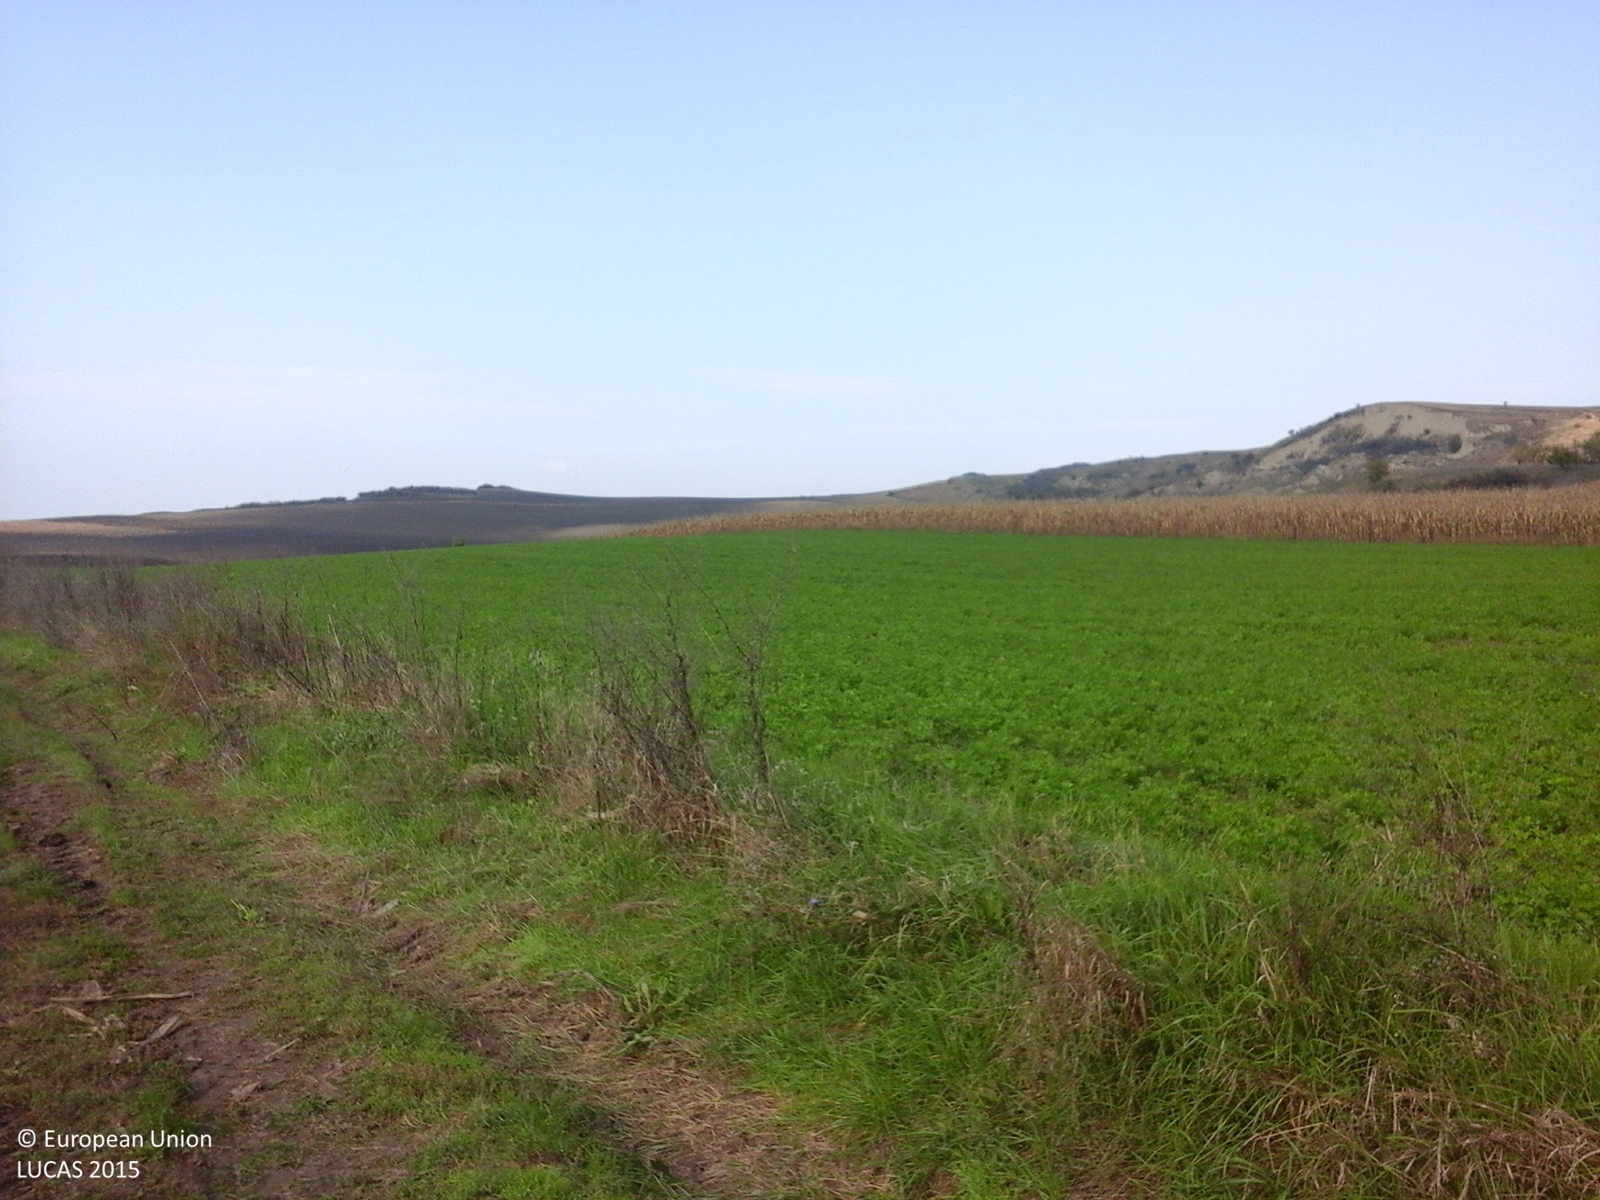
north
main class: Cropland
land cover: Maize
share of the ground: > 75 %
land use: Agriculture (excluding fallow land and kitchen gardens)
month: October
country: RO
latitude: 46.4045
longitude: 24.3258
